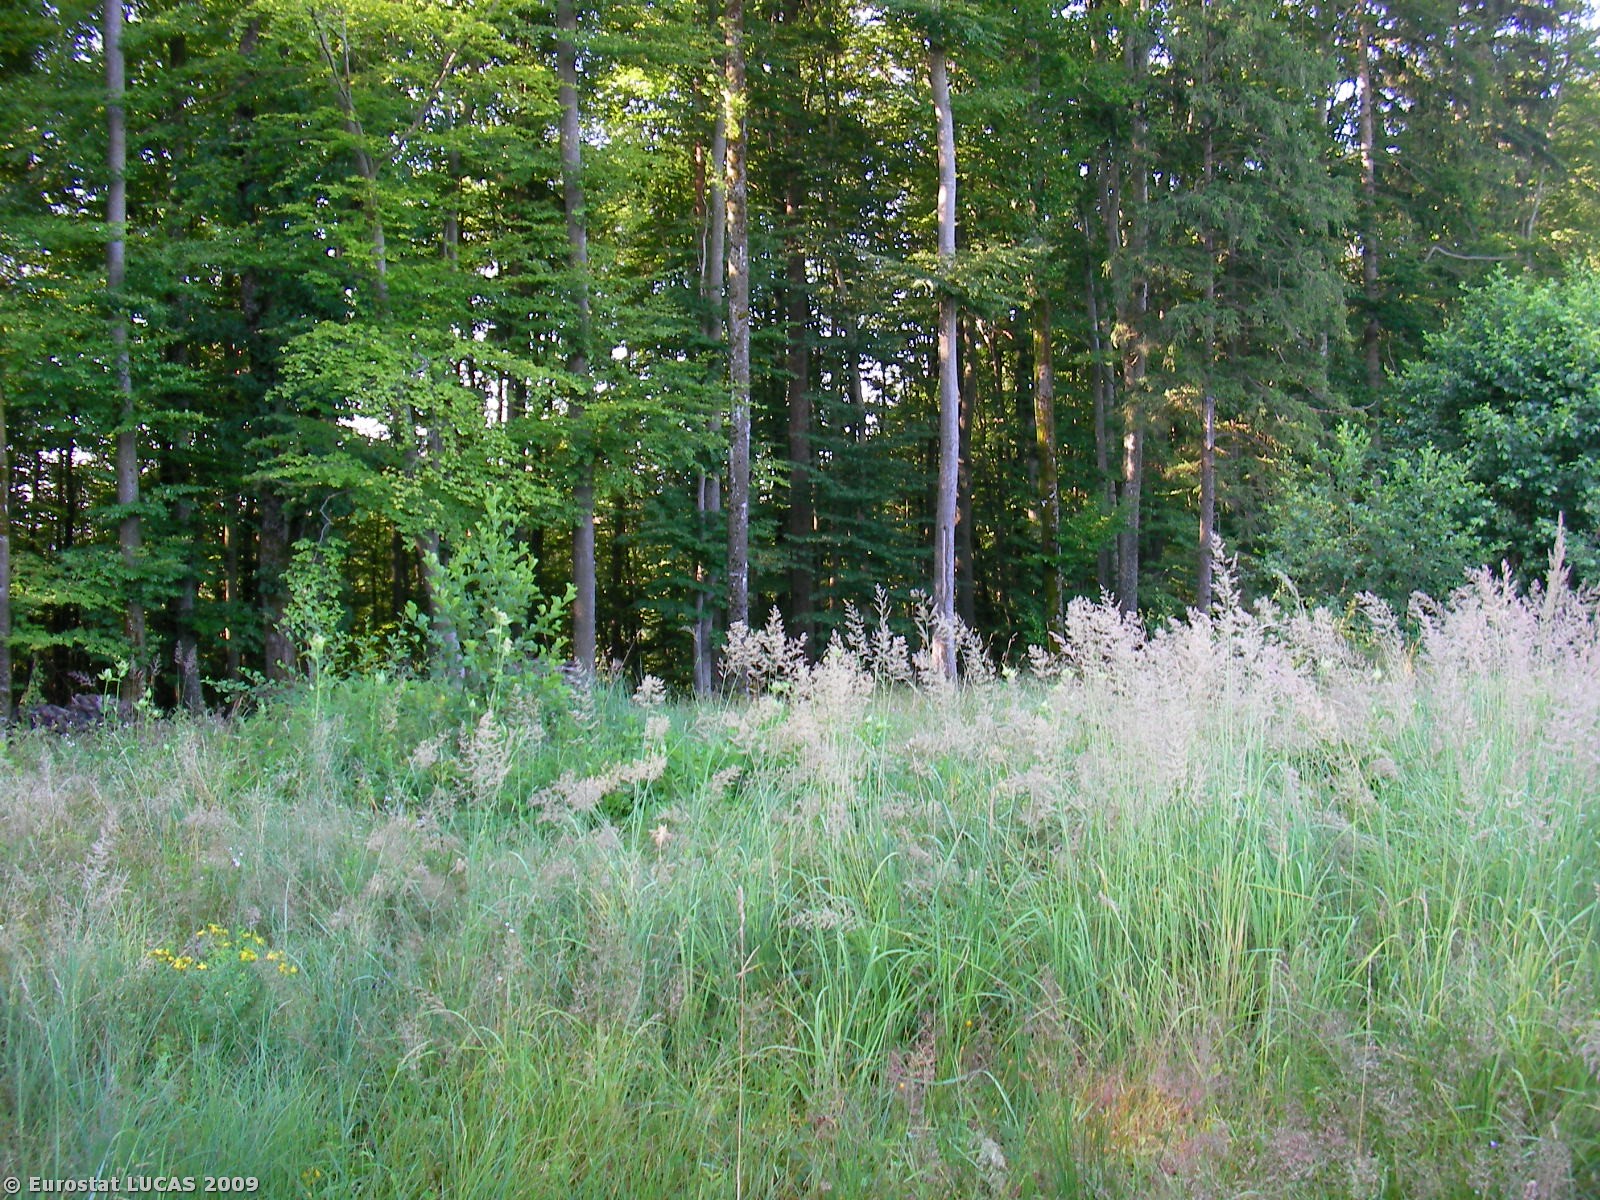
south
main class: Cropland
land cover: Maize
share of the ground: > 75 %
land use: Agriculture (excluding fallow land and kitchen gardens)
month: July
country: AT
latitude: 46.9565
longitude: 15.7163
